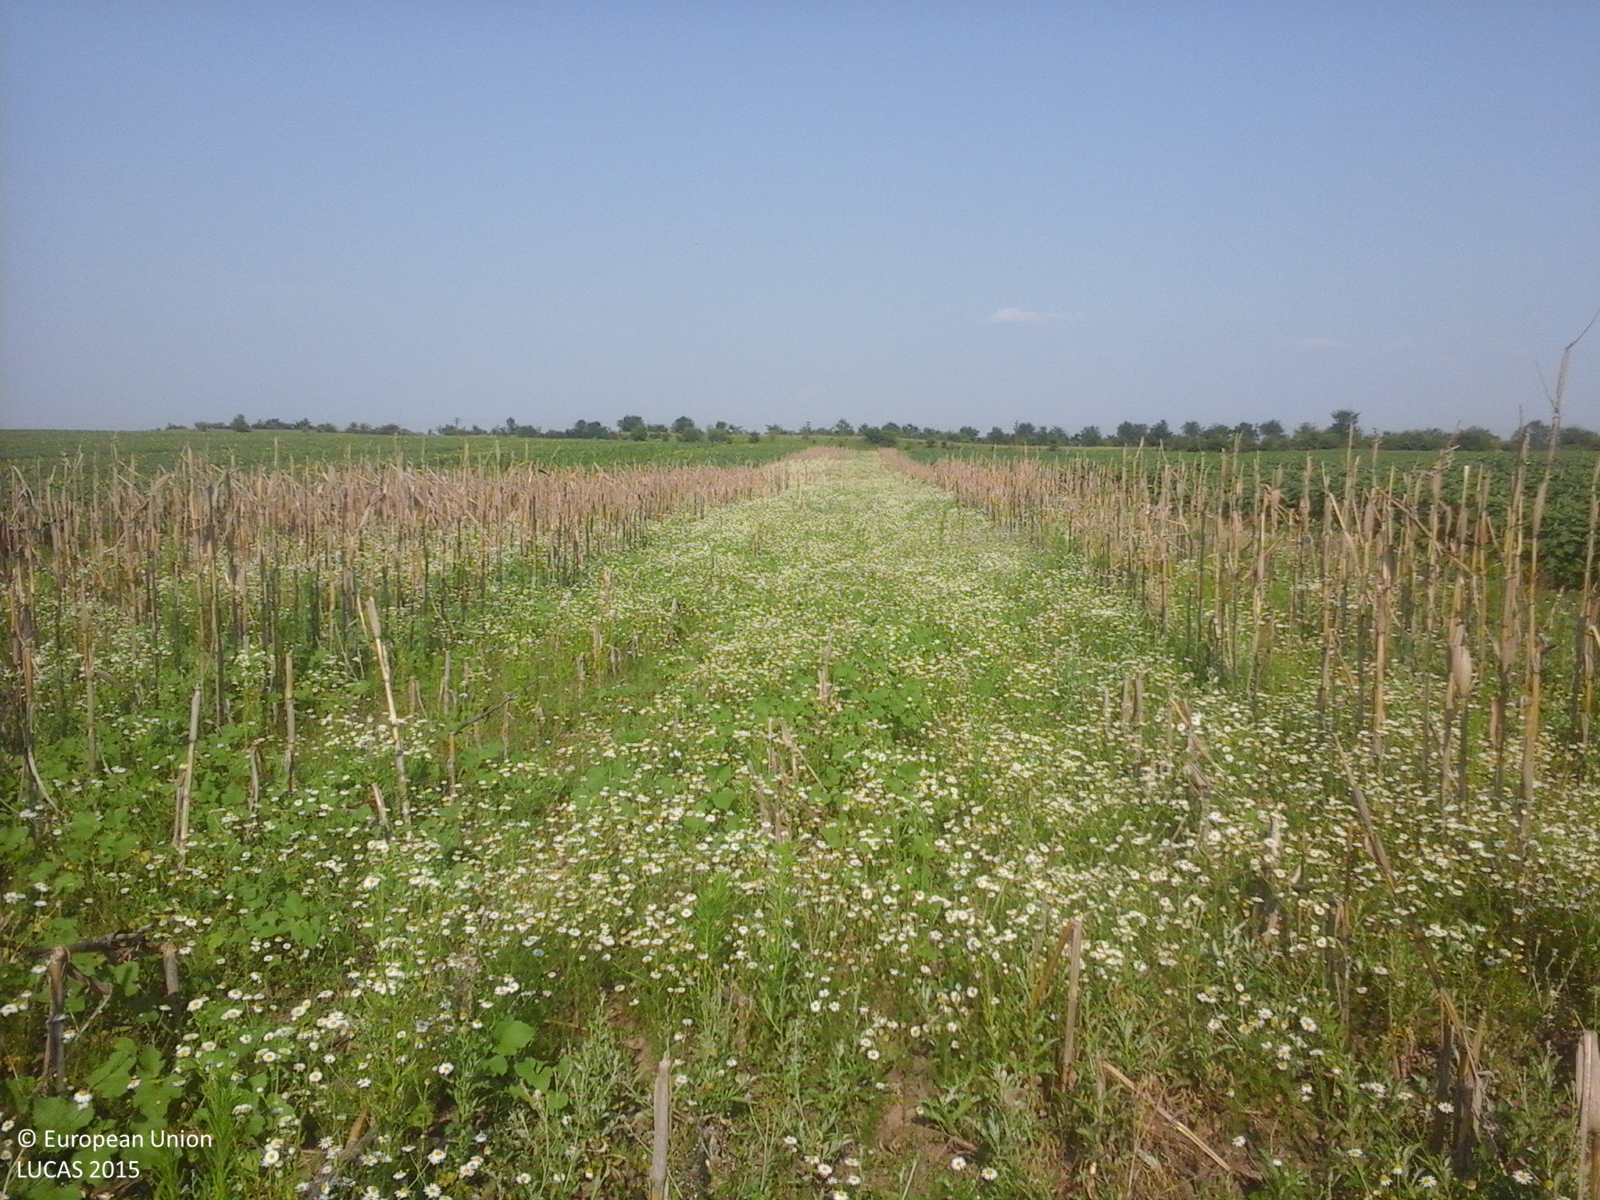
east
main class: Grassland
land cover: Spontaneously vegetated surfaces
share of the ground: > 75 %
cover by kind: herbaceous plants 100 %
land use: Fallow land
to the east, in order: Spontaneously vegetated surfaces
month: July
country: RO
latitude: 44.5329
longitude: 24.7621
